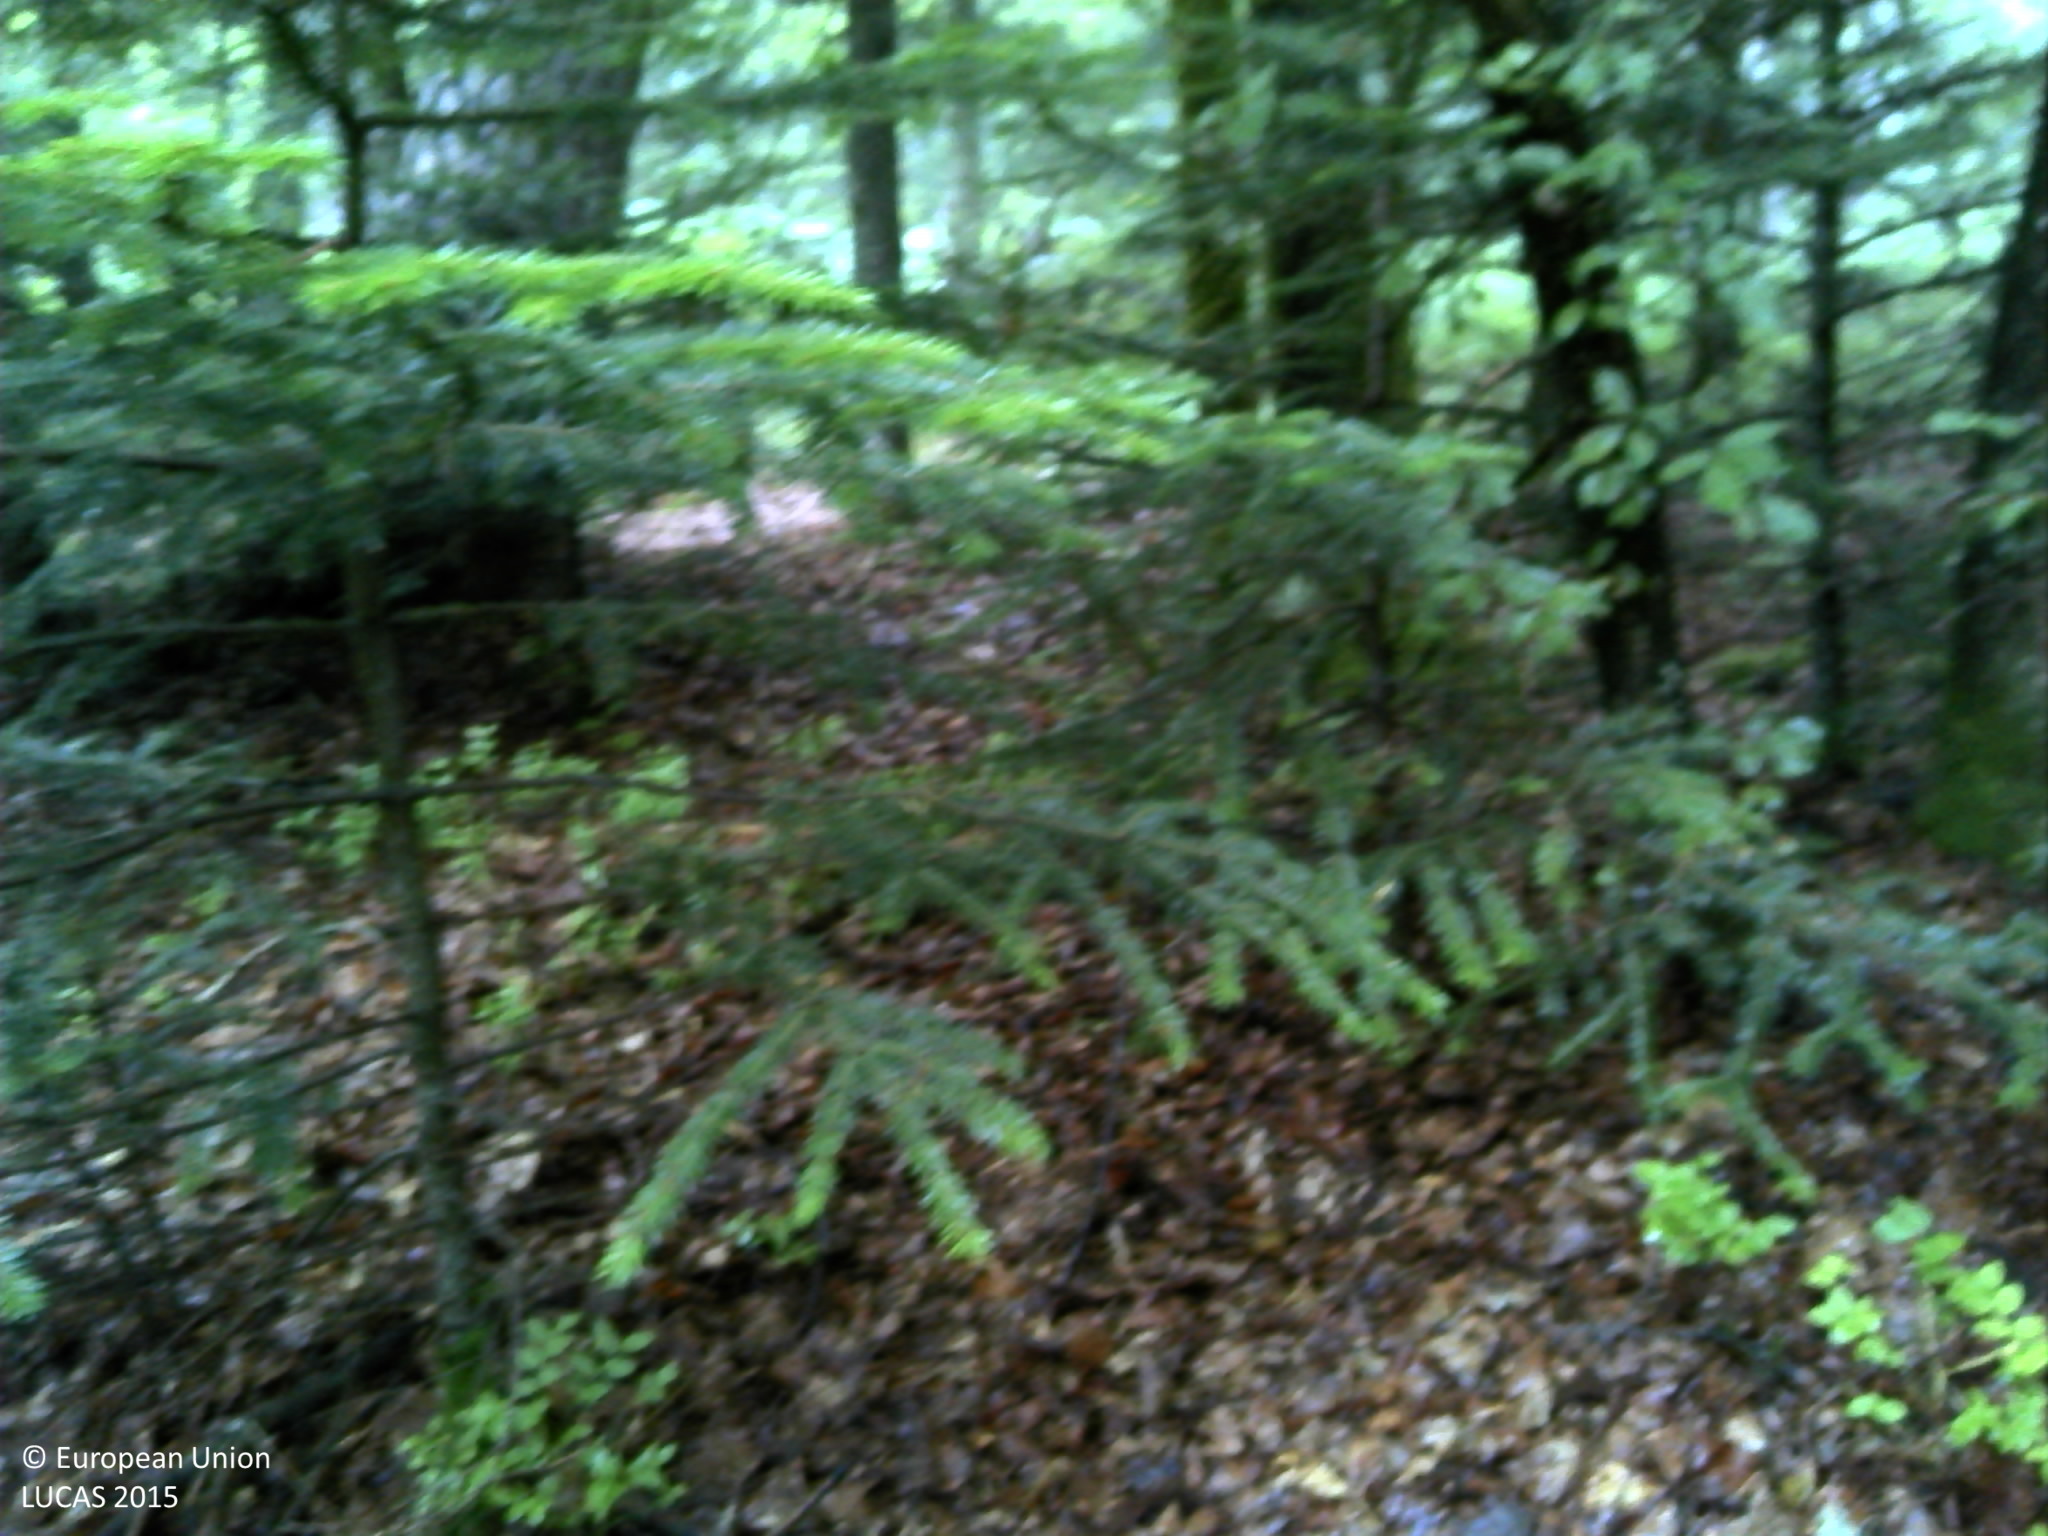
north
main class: Woodland
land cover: Pine dominated mixed woodland
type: alpine coniferous forest
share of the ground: > 75 %
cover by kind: broadleaved forest trees 60 %, coniferous forest trees 40 %
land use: Forestry
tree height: > 5 m
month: August
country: FR
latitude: 48.2142
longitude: 6.8382
